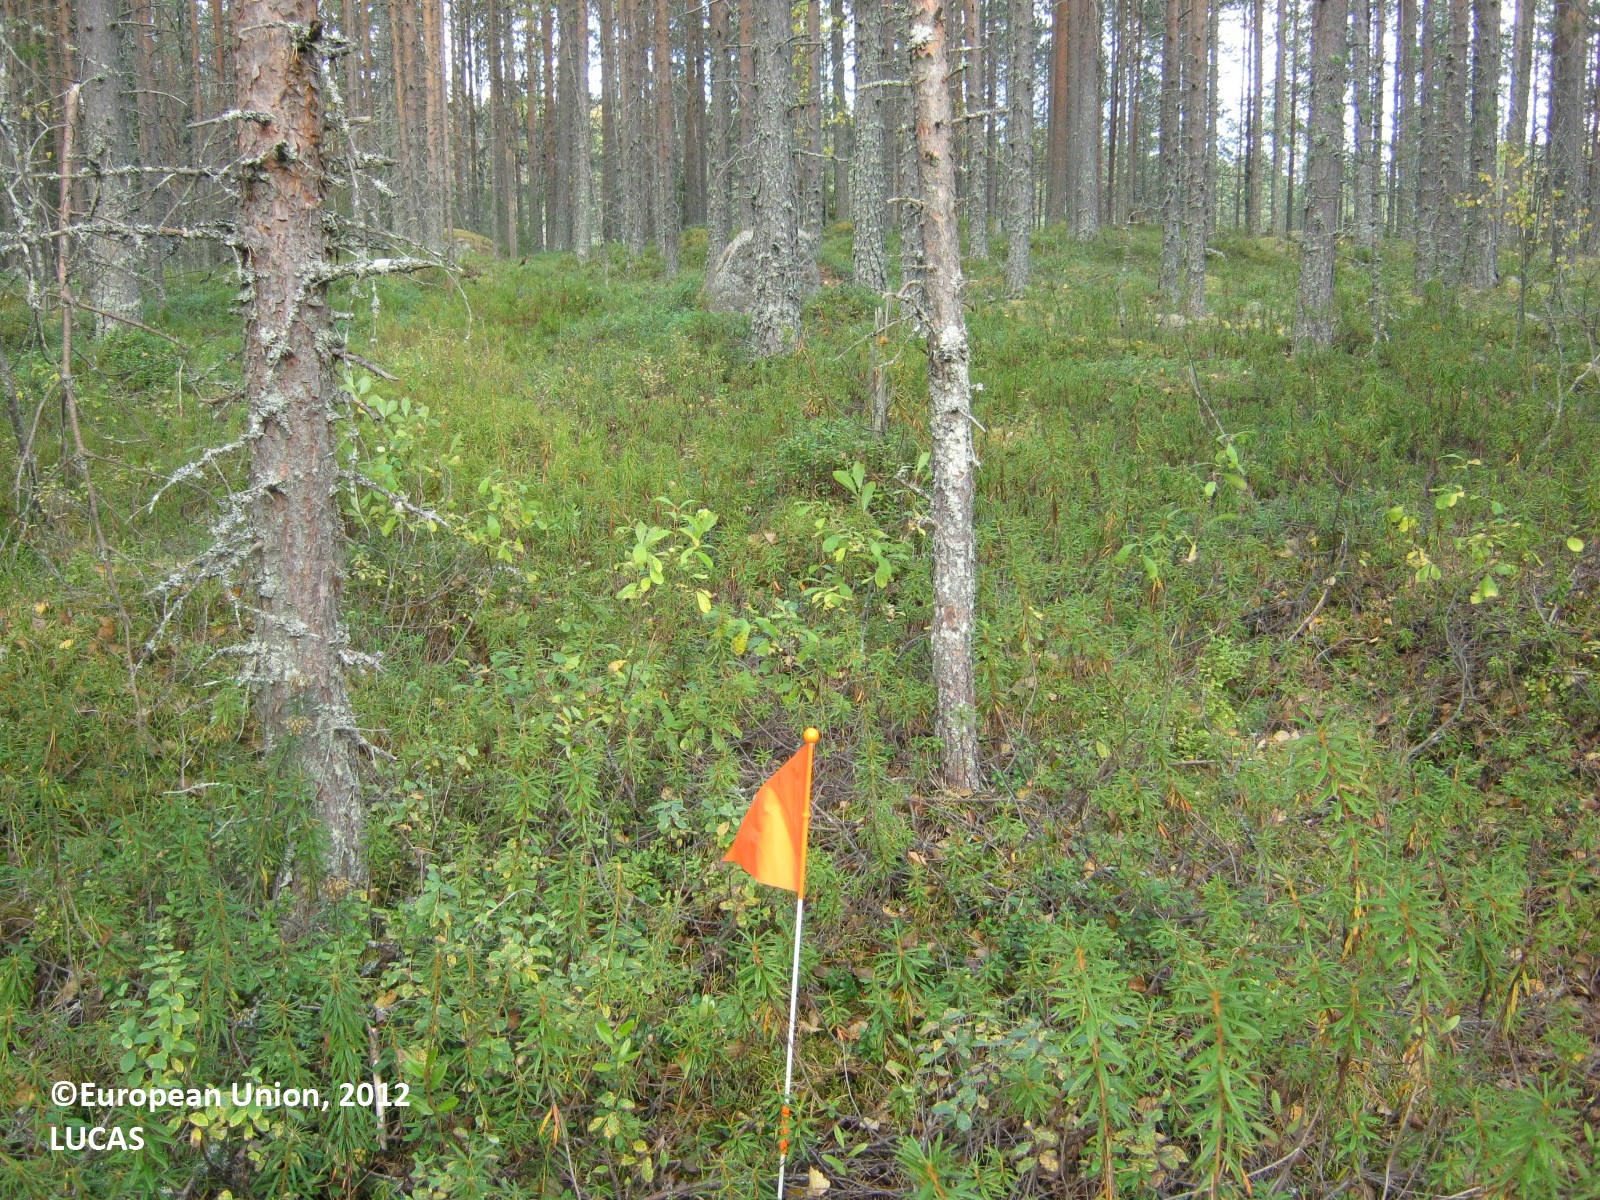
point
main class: Woodland
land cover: Pine dominated coniferous woodland
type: boreal forest
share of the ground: > 75 %
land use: Forestry
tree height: > 5 m
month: September
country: FI
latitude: 63.4985
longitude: 25.8786
